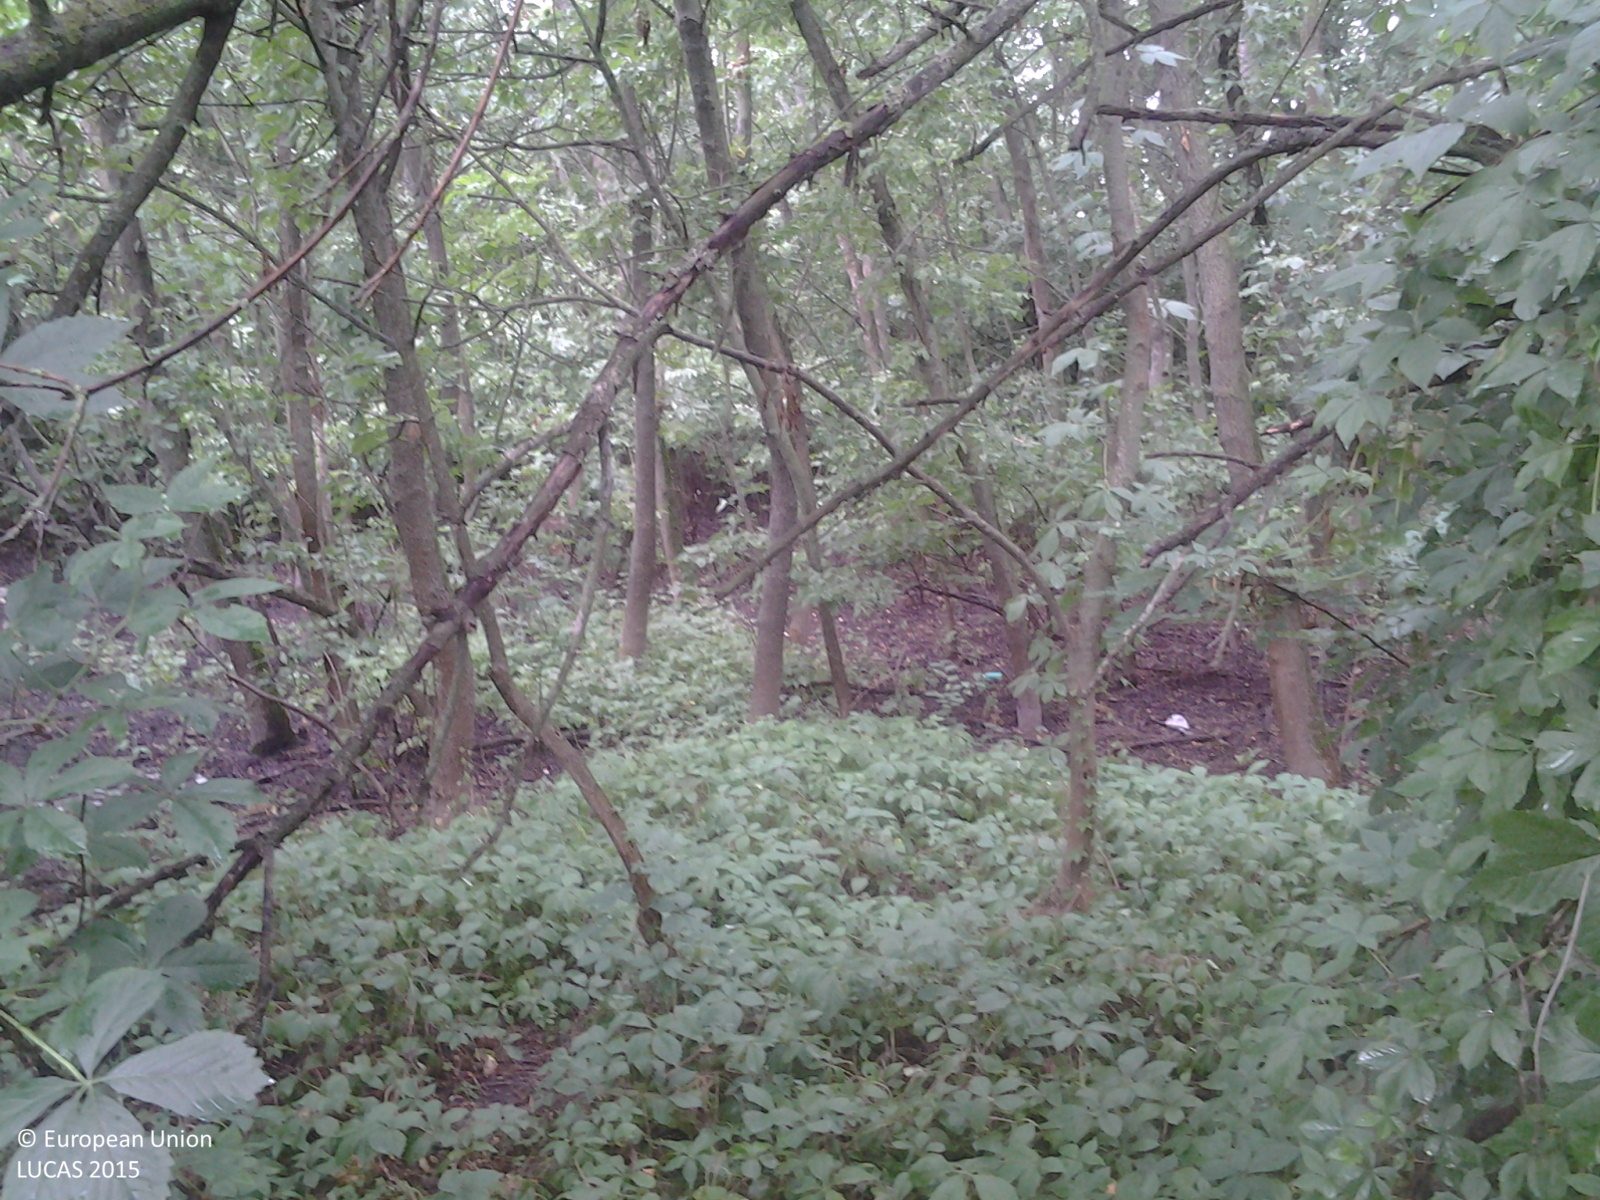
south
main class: Woodland
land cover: Broadleaved woodland
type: mesophytic deciduous forest
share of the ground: 50 - 75 %
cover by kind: broadleaved forest trees 60 %, shrubs 20 %, herbaceous plants 20 %
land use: Forestry
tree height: > 5 m
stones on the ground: < 10 %
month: August
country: HU
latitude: 46.9407
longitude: 21.2158
